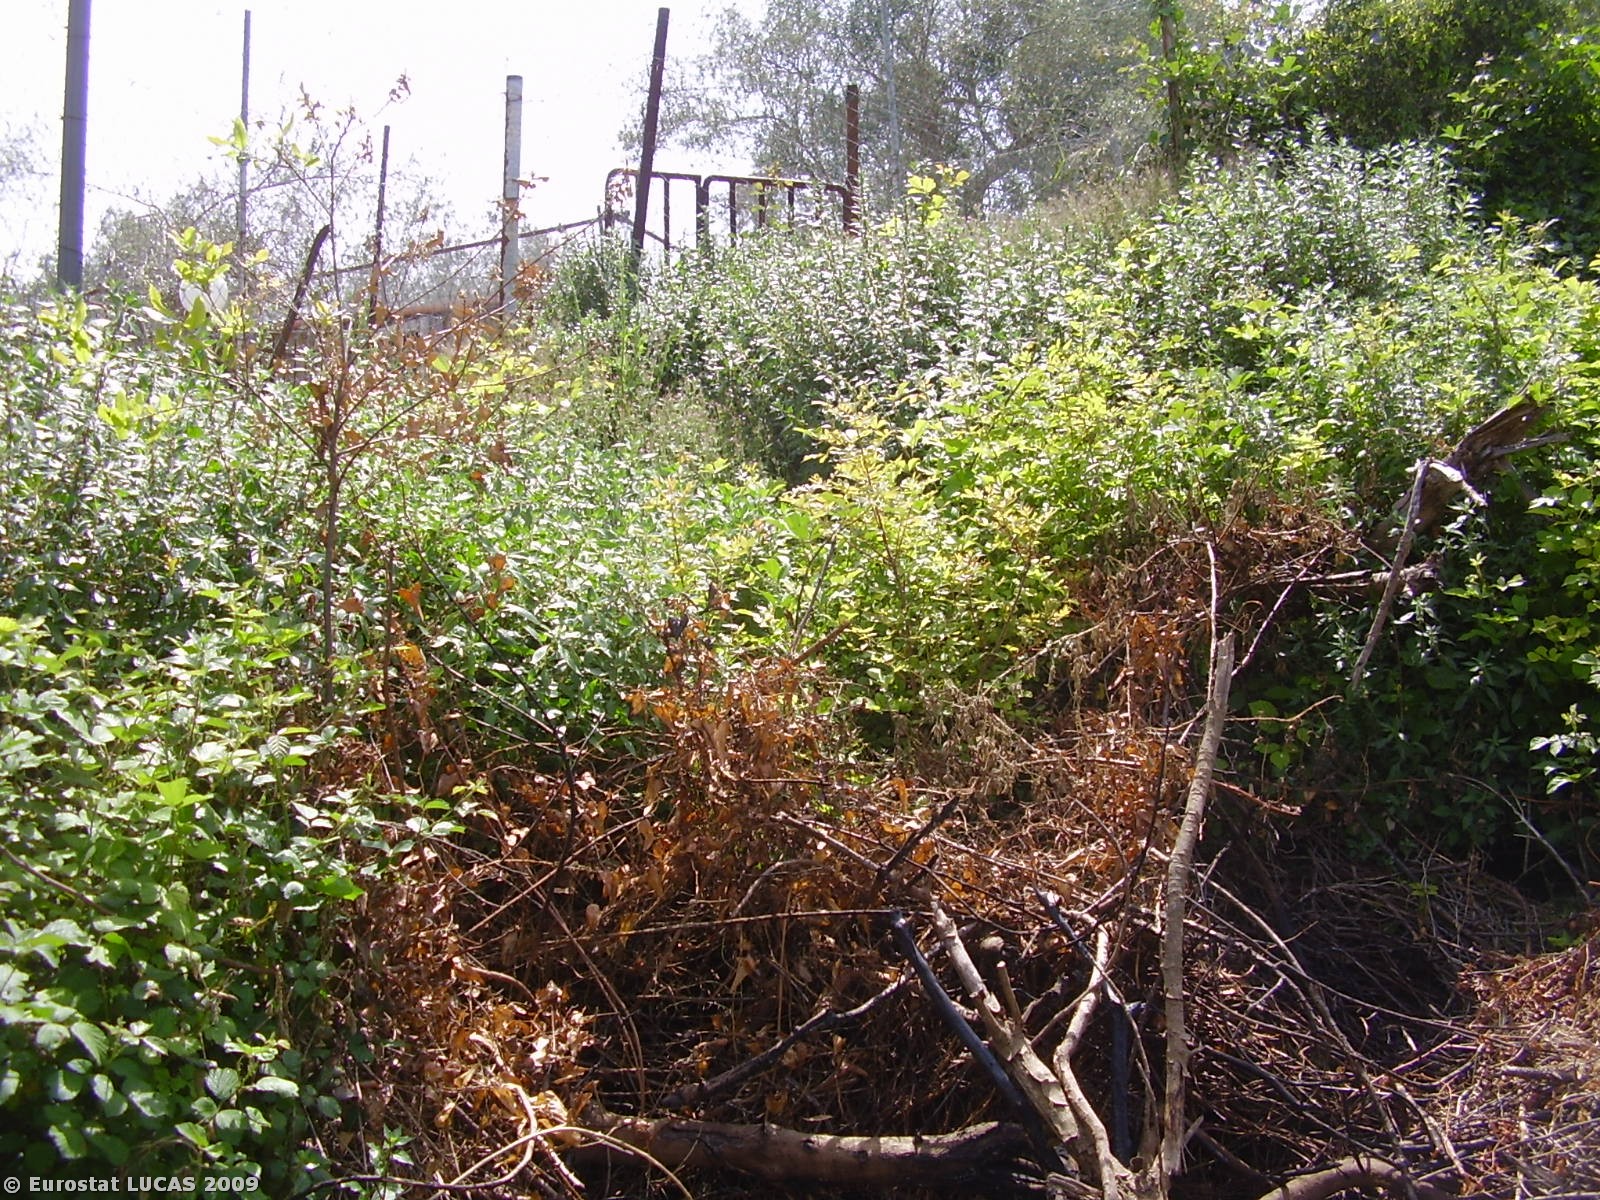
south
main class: Shrubland
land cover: Shrubland with sparse tree cover
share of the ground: 50 - 75 %
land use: Agriculture (excluding fallow land and kitchen gardens)
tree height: < 5 m
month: May
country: IT
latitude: 37.1276
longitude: 14.9485
